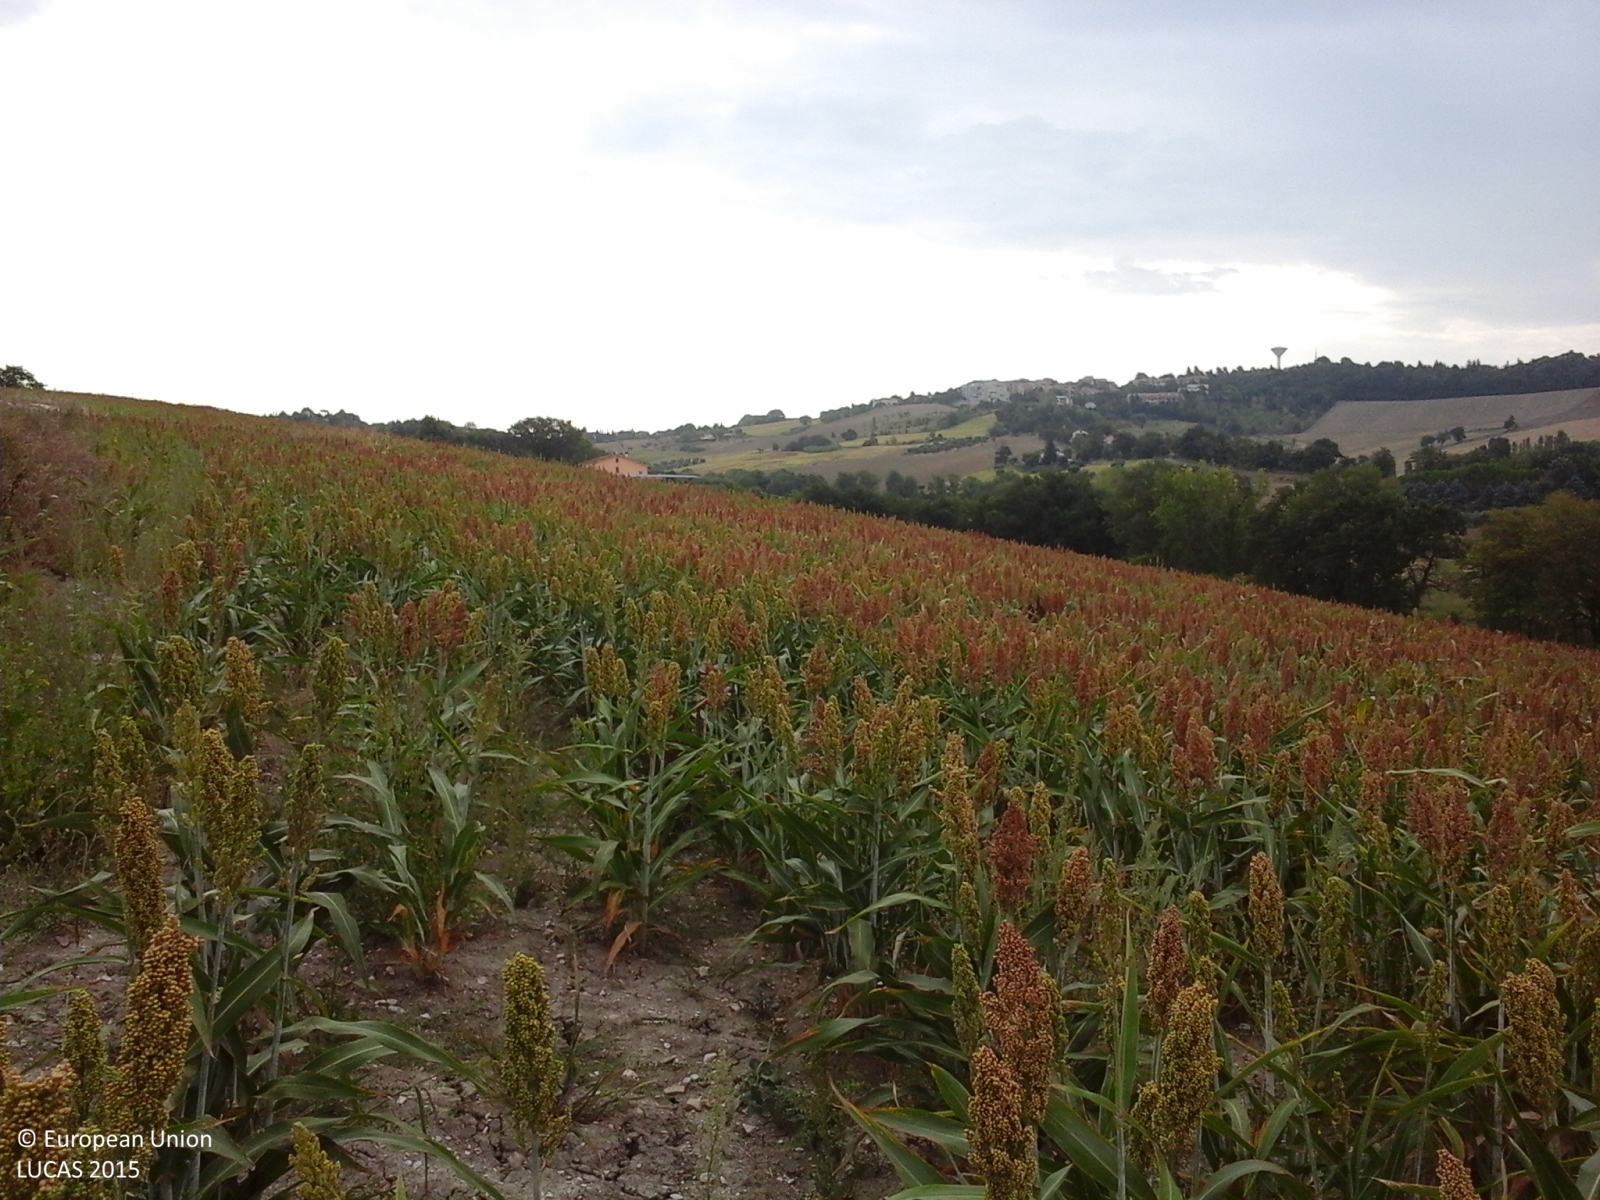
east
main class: Cropland
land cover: Other cereals
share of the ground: > 75 %
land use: Agriculture (excluding fallow land and kitchen gardens)
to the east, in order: Other cereals
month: August
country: IT
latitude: 43.3015
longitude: 13.4059
